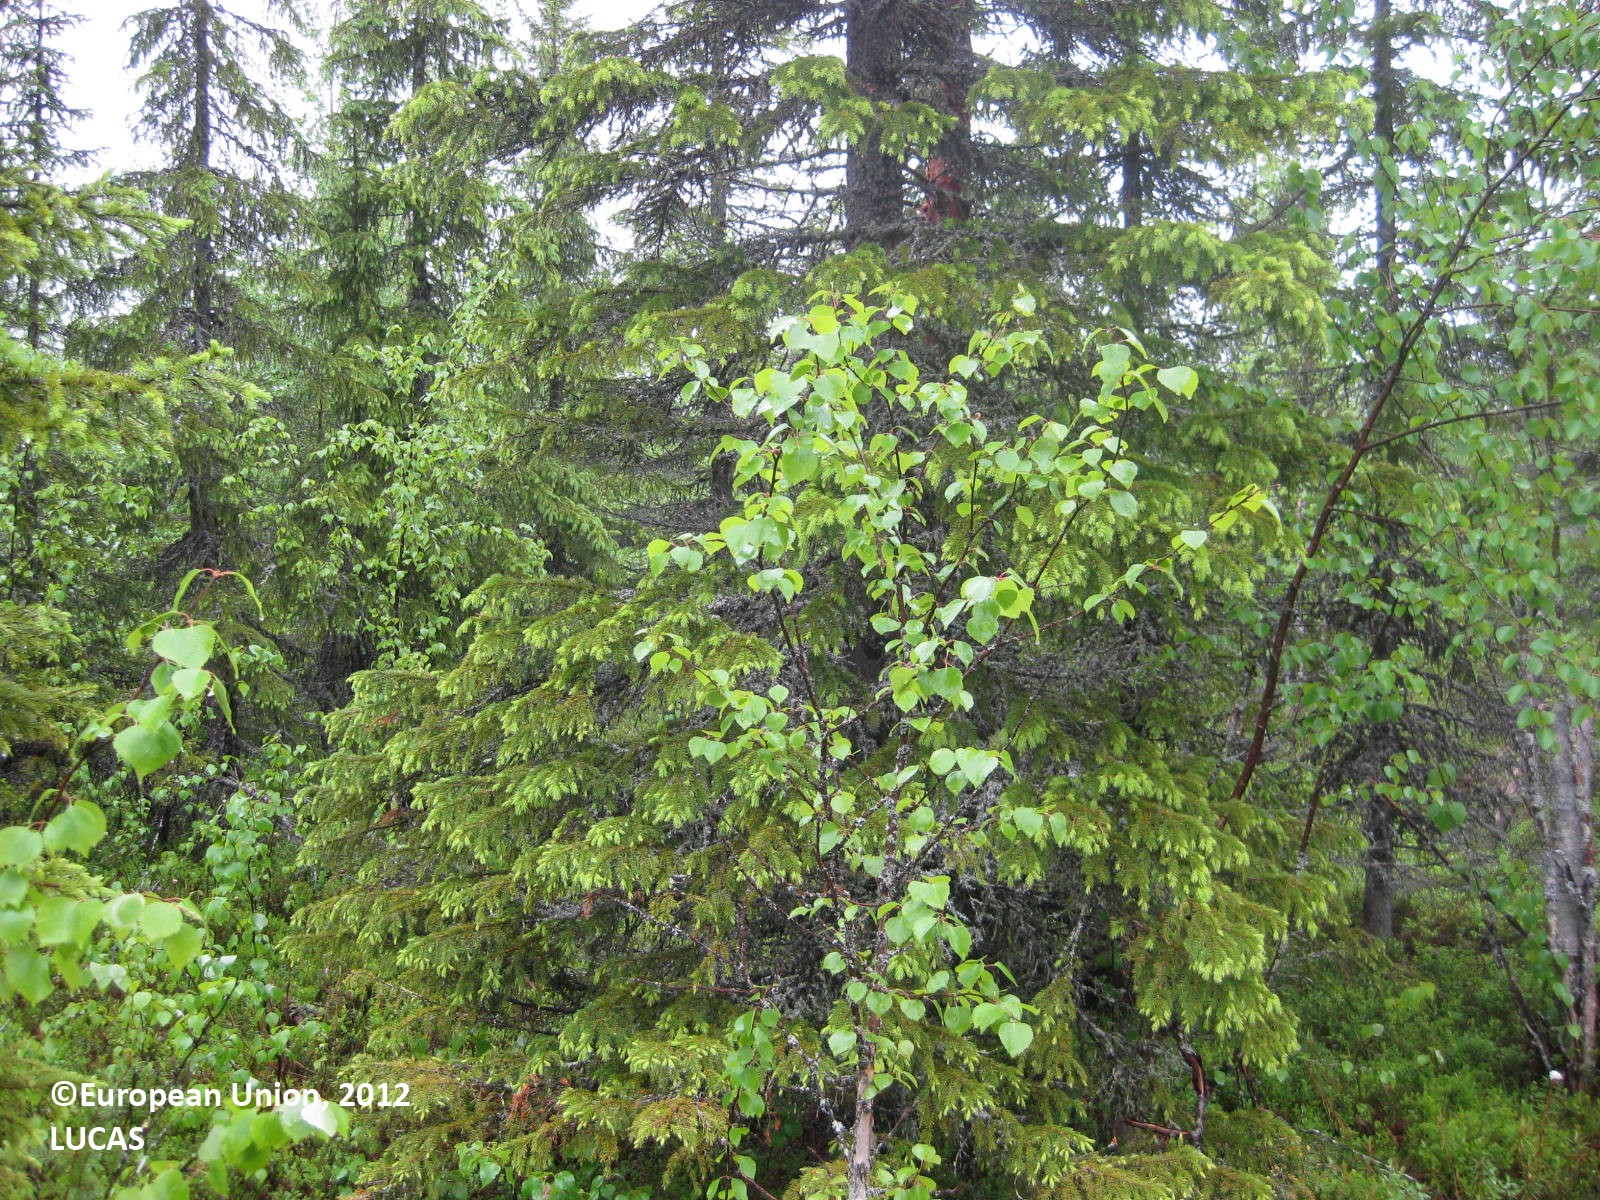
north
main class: Woodland
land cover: Other mixed woodland
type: boreal forest
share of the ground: 50 - 75 %
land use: Forestry
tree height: > 5 m
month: June
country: FI
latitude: 65.3449
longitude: 29.0240
